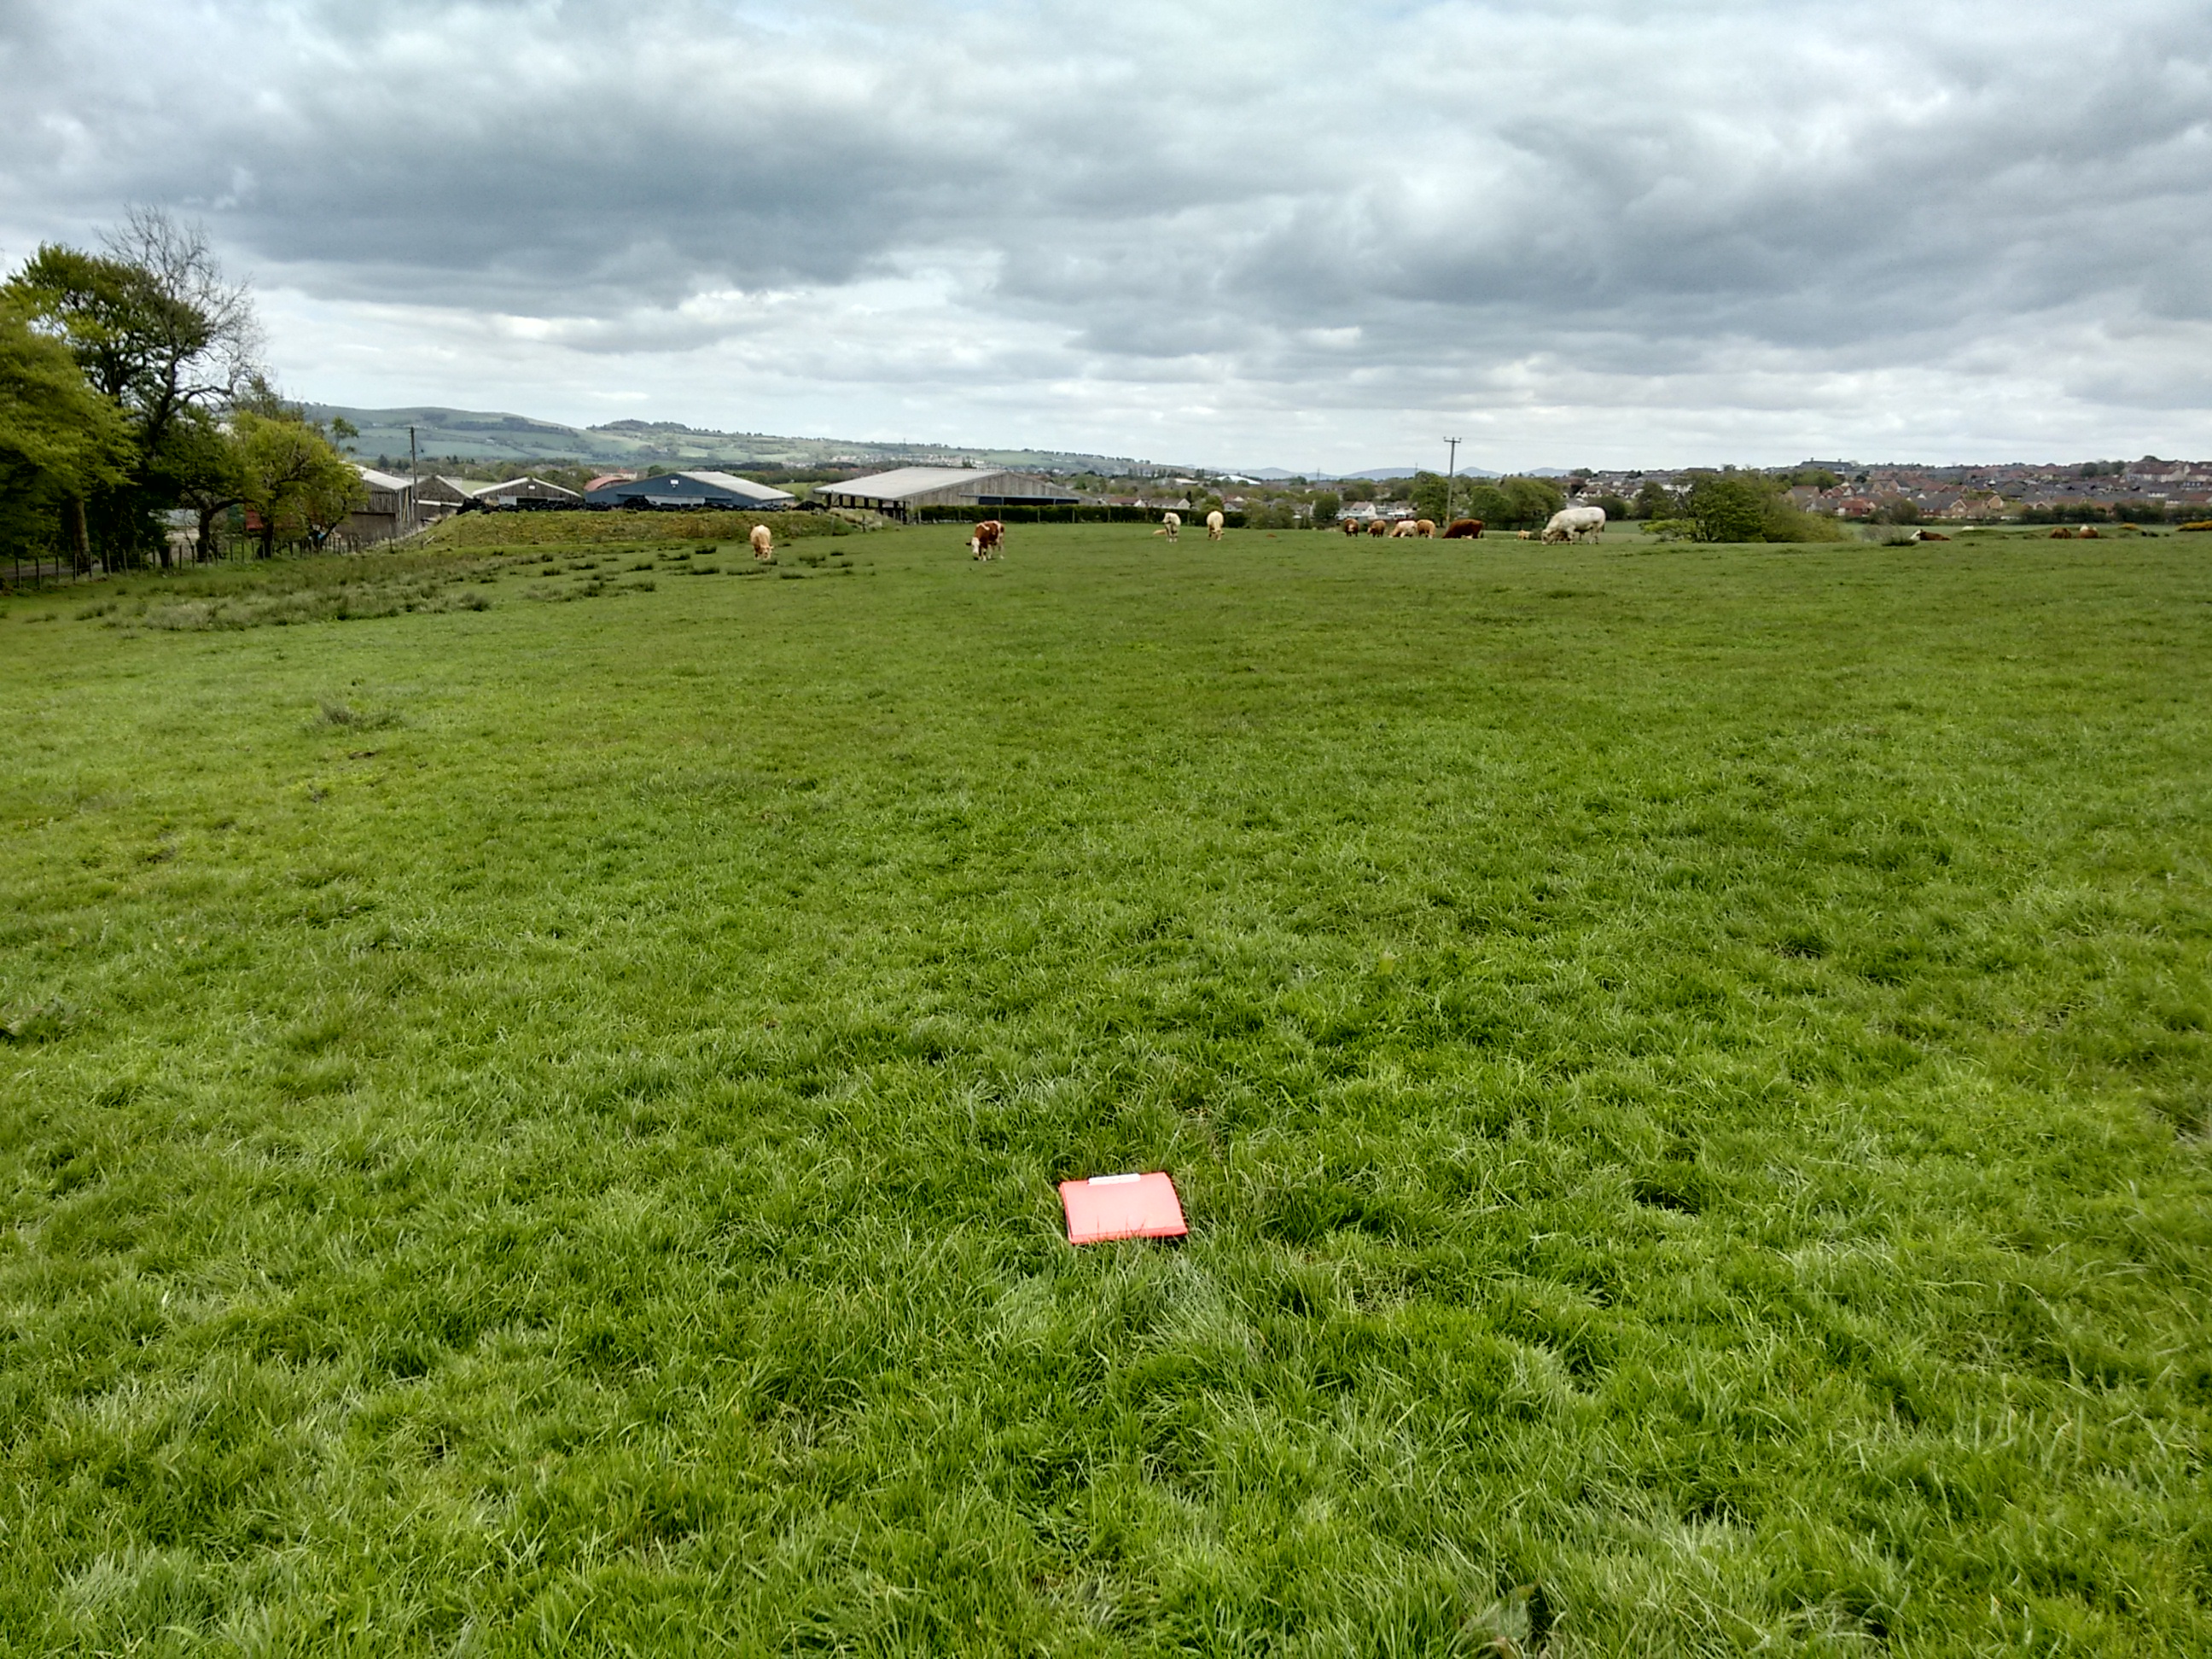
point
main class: Grassland
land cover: Grassland without tree/shrub cover
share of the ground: > 75 %
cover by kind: herbaceous plants 100 %
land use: Agriculture (excluding fallow land and kitchen gardens)
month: May
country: GB
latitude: 55.9022
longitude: -3.7252
